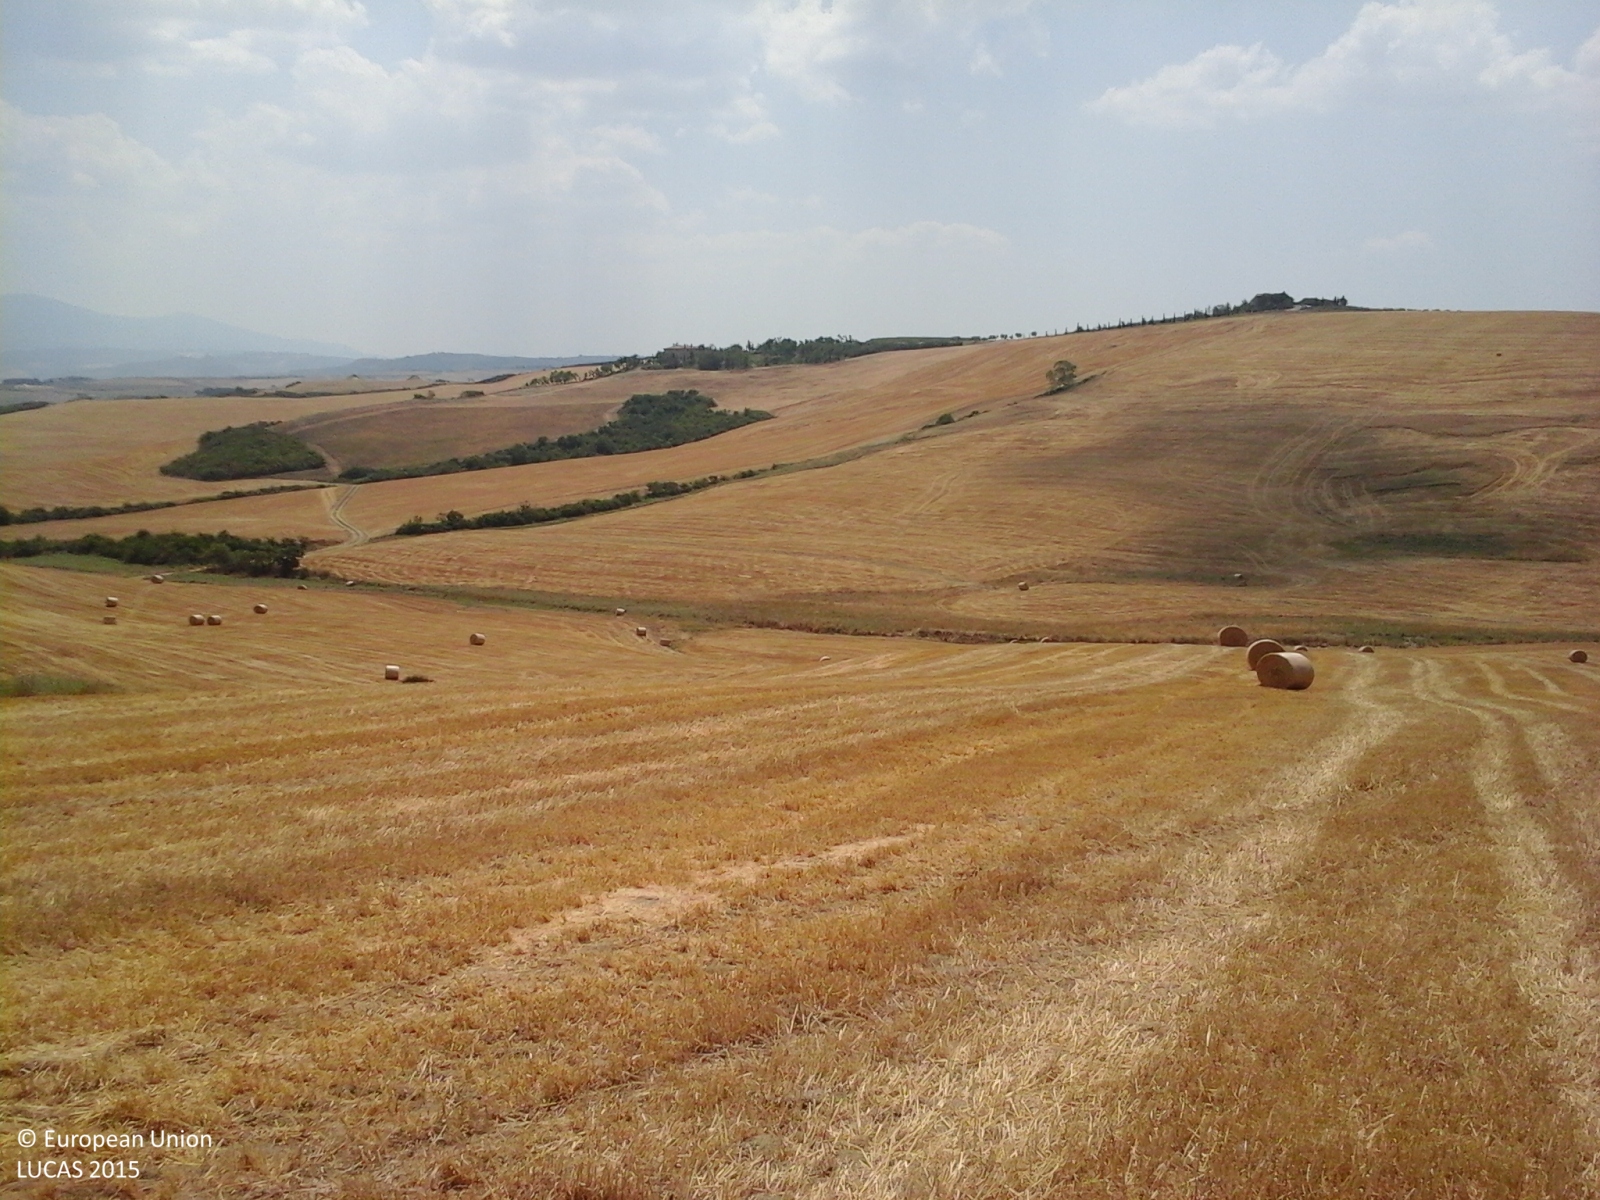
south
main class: Cropland
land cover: Durum wheat
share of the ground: > 75 %
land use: Agriculture (excluding fallow land and kitchen gardens)
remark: Harvested field
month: July
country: IT
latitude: 43.1105
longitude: 11.6295
